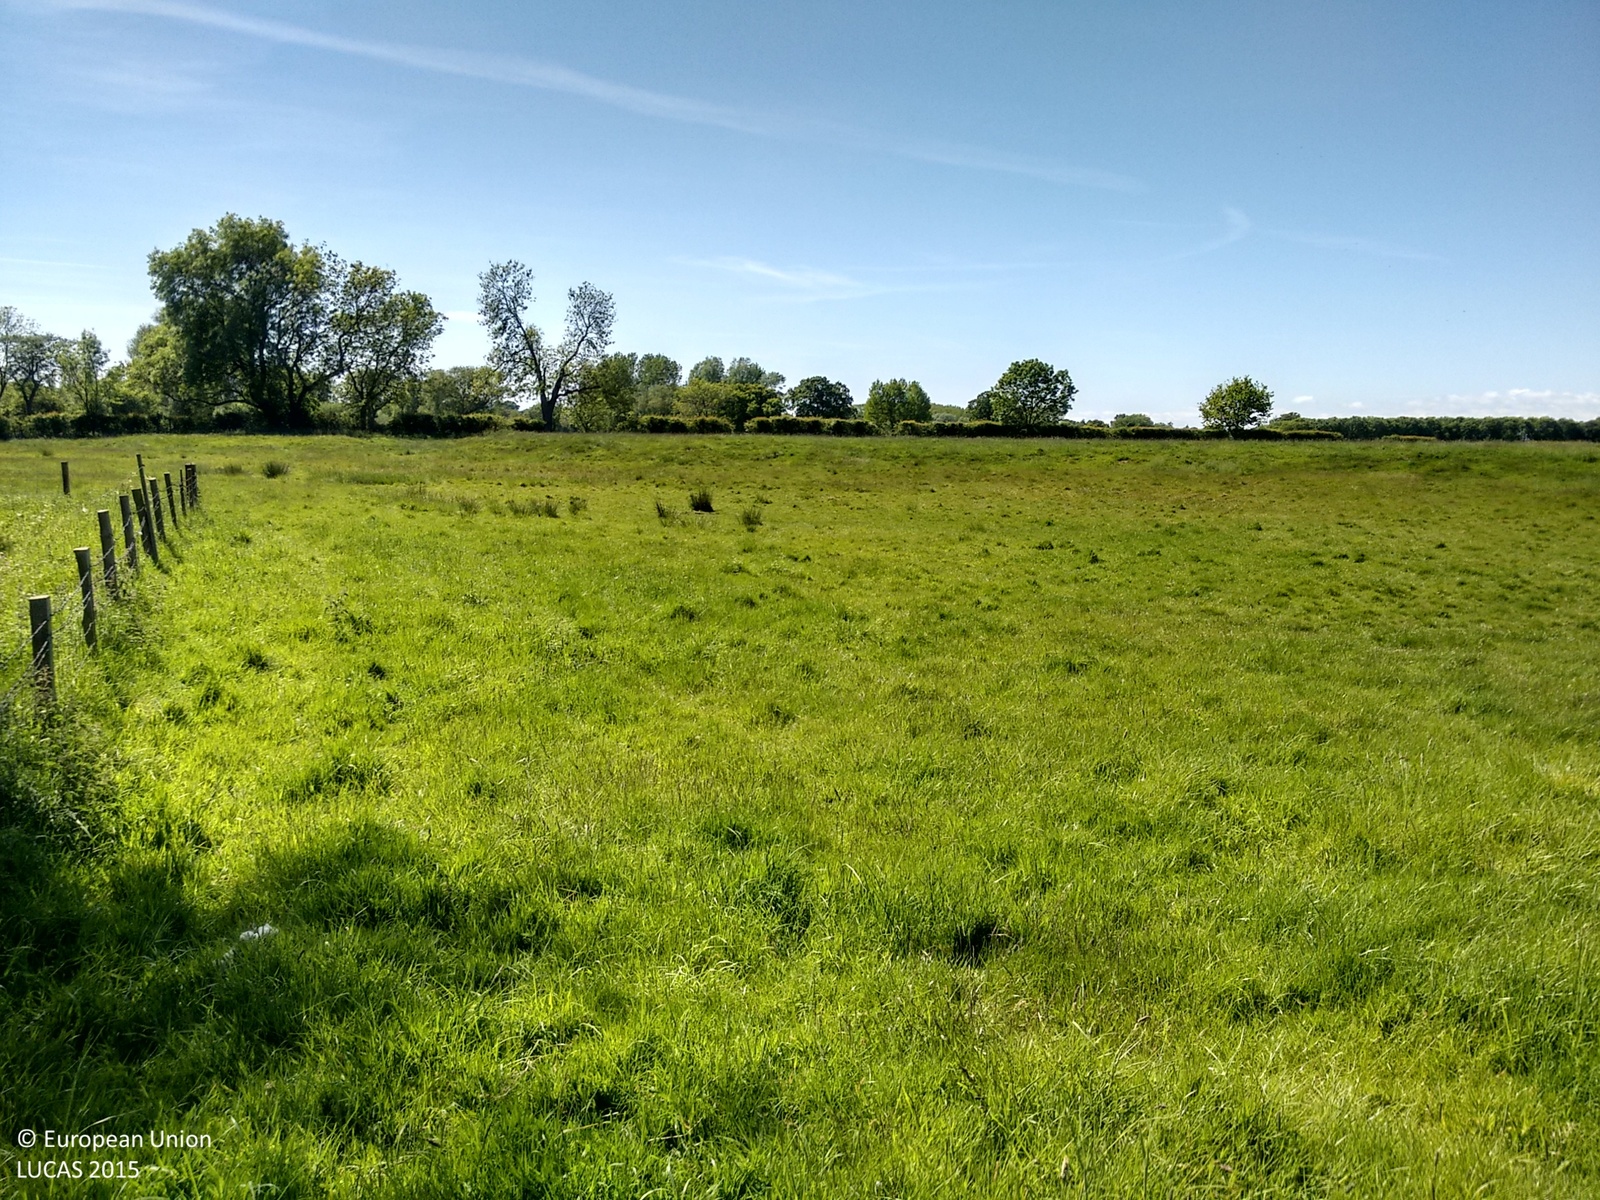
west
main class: Grassland
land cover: Spontaneously vegetated surfaces
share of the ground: > 75 %
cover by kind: herbaceous plants 100 %
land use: Agriculture (excluding fallow land and kitchen gardens)
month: June
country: GB
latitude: 54.0693
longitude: -0.9062
